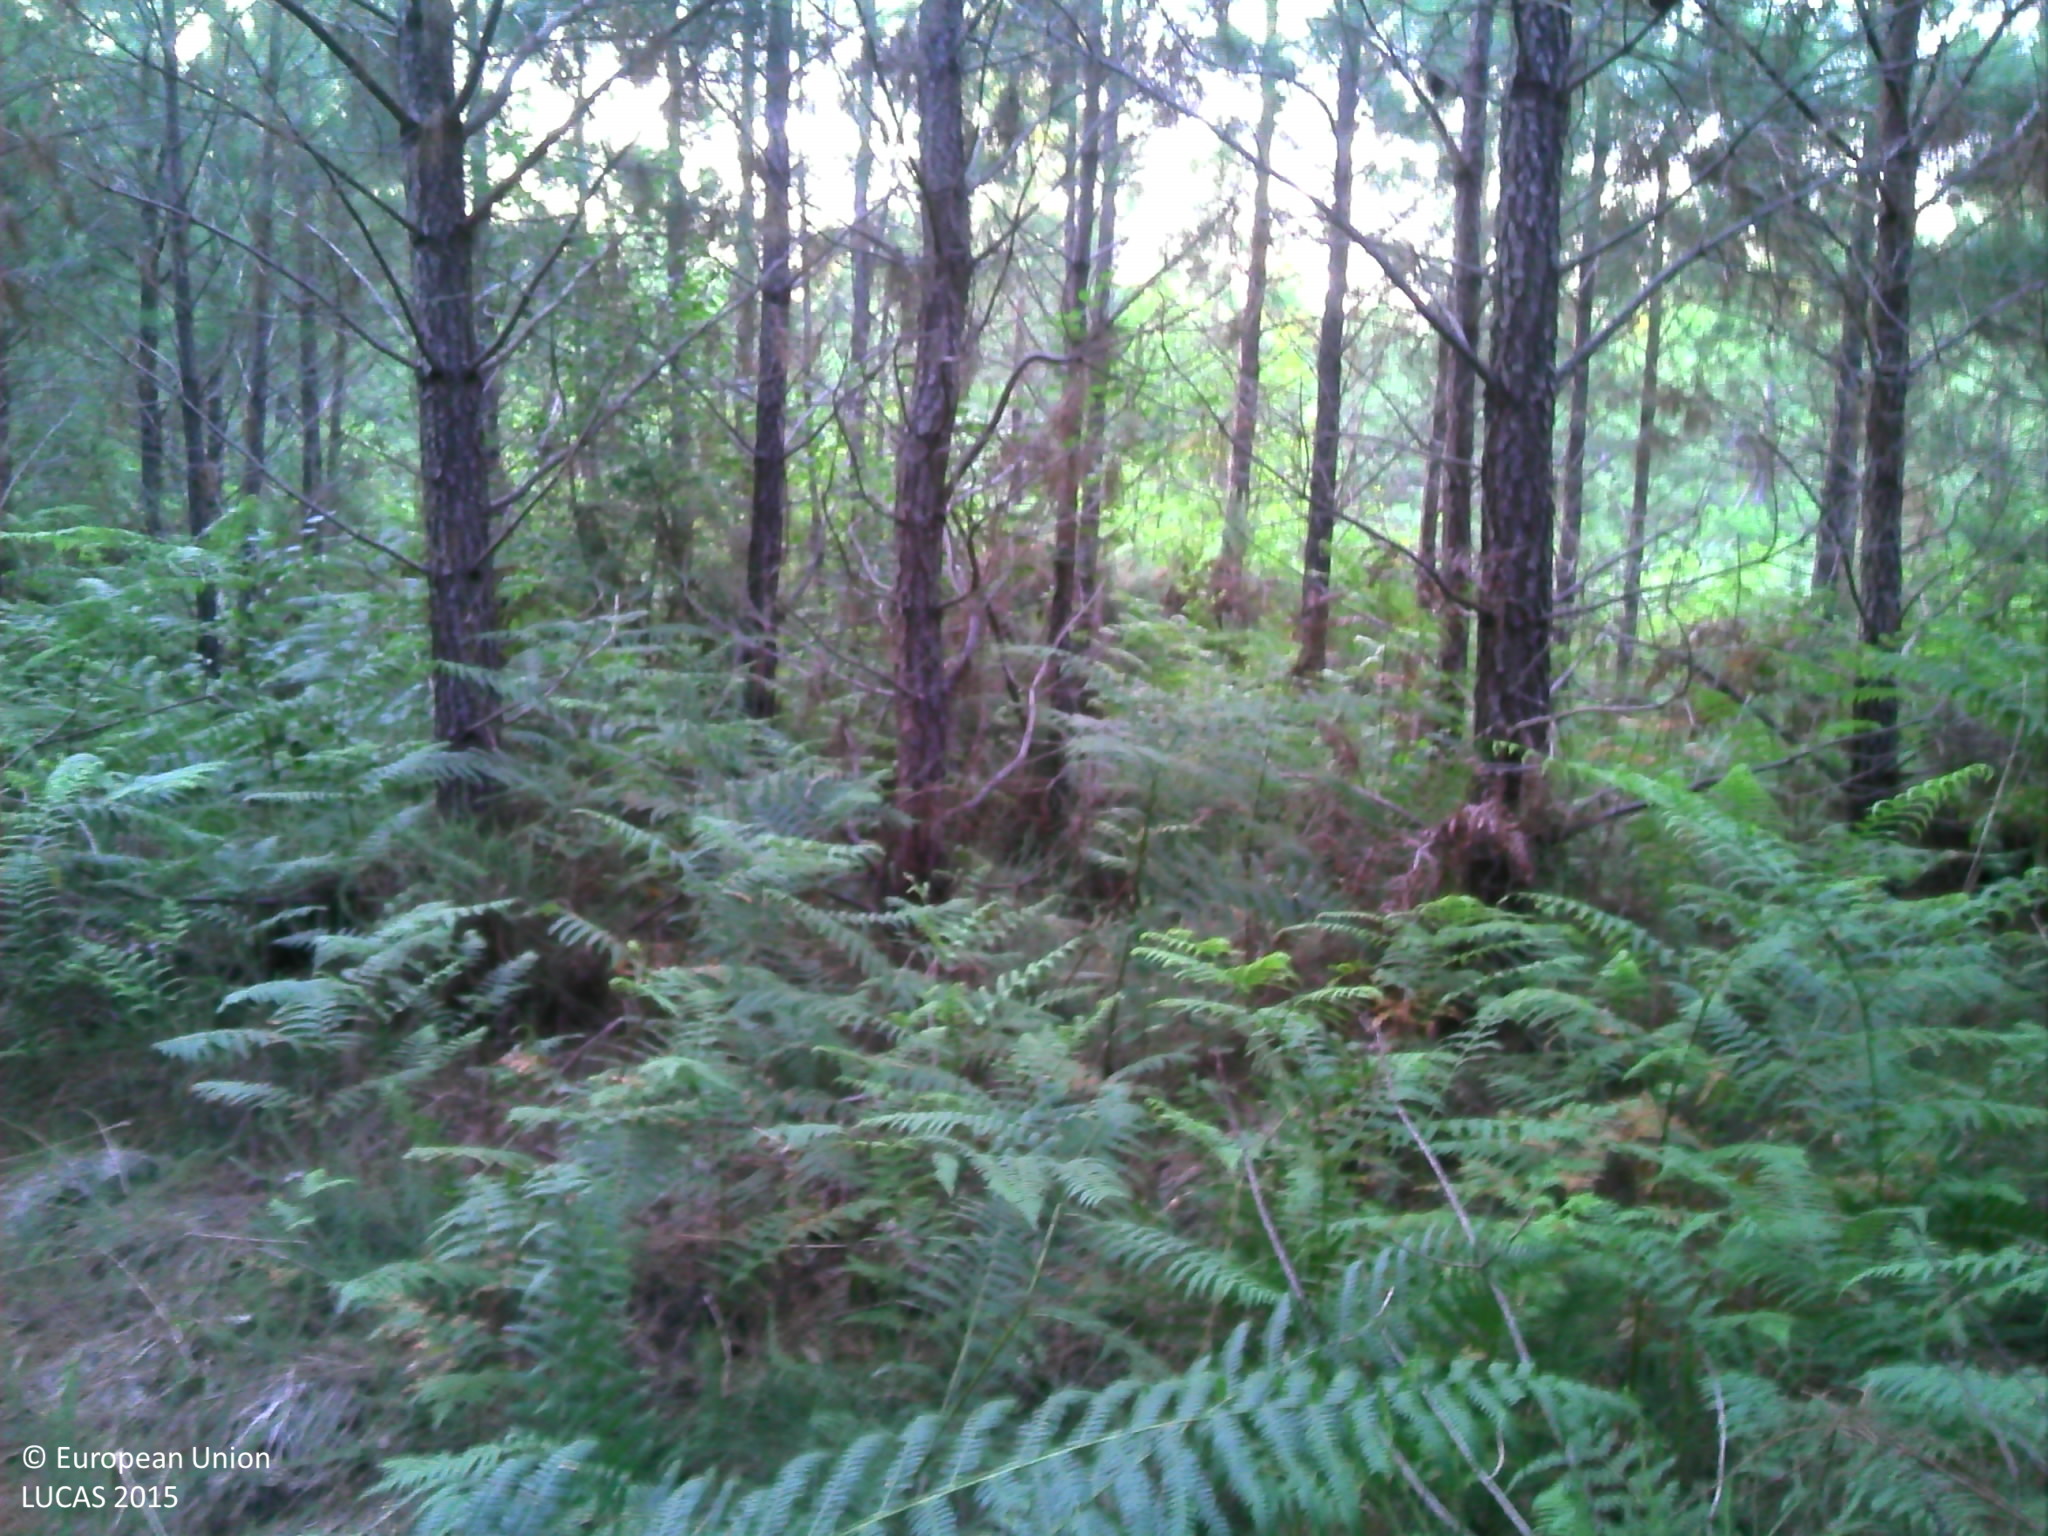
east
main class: Woodland
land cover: Pine dominated coniferous woodland
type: coniferous forest of the mediterranean region
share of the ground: > 75 %
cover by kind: coniferous forest trees 90 %, shrubs 5 %, herbaceous plants 5 %
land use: Forestry
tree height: > 5 m
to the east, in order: Pine dominated coniferous woodland; Grass margins; Other bare soil; Fences; Grassland with sparse tree/shrub cover; Paved roads, cycling and walking lanes; Fences; Spontaneously vegetated surfaces; Ditches and canals; Fences; Pine dominated coniferous woodland
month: June
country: FR
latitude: 43.9547
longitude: -0.3917
